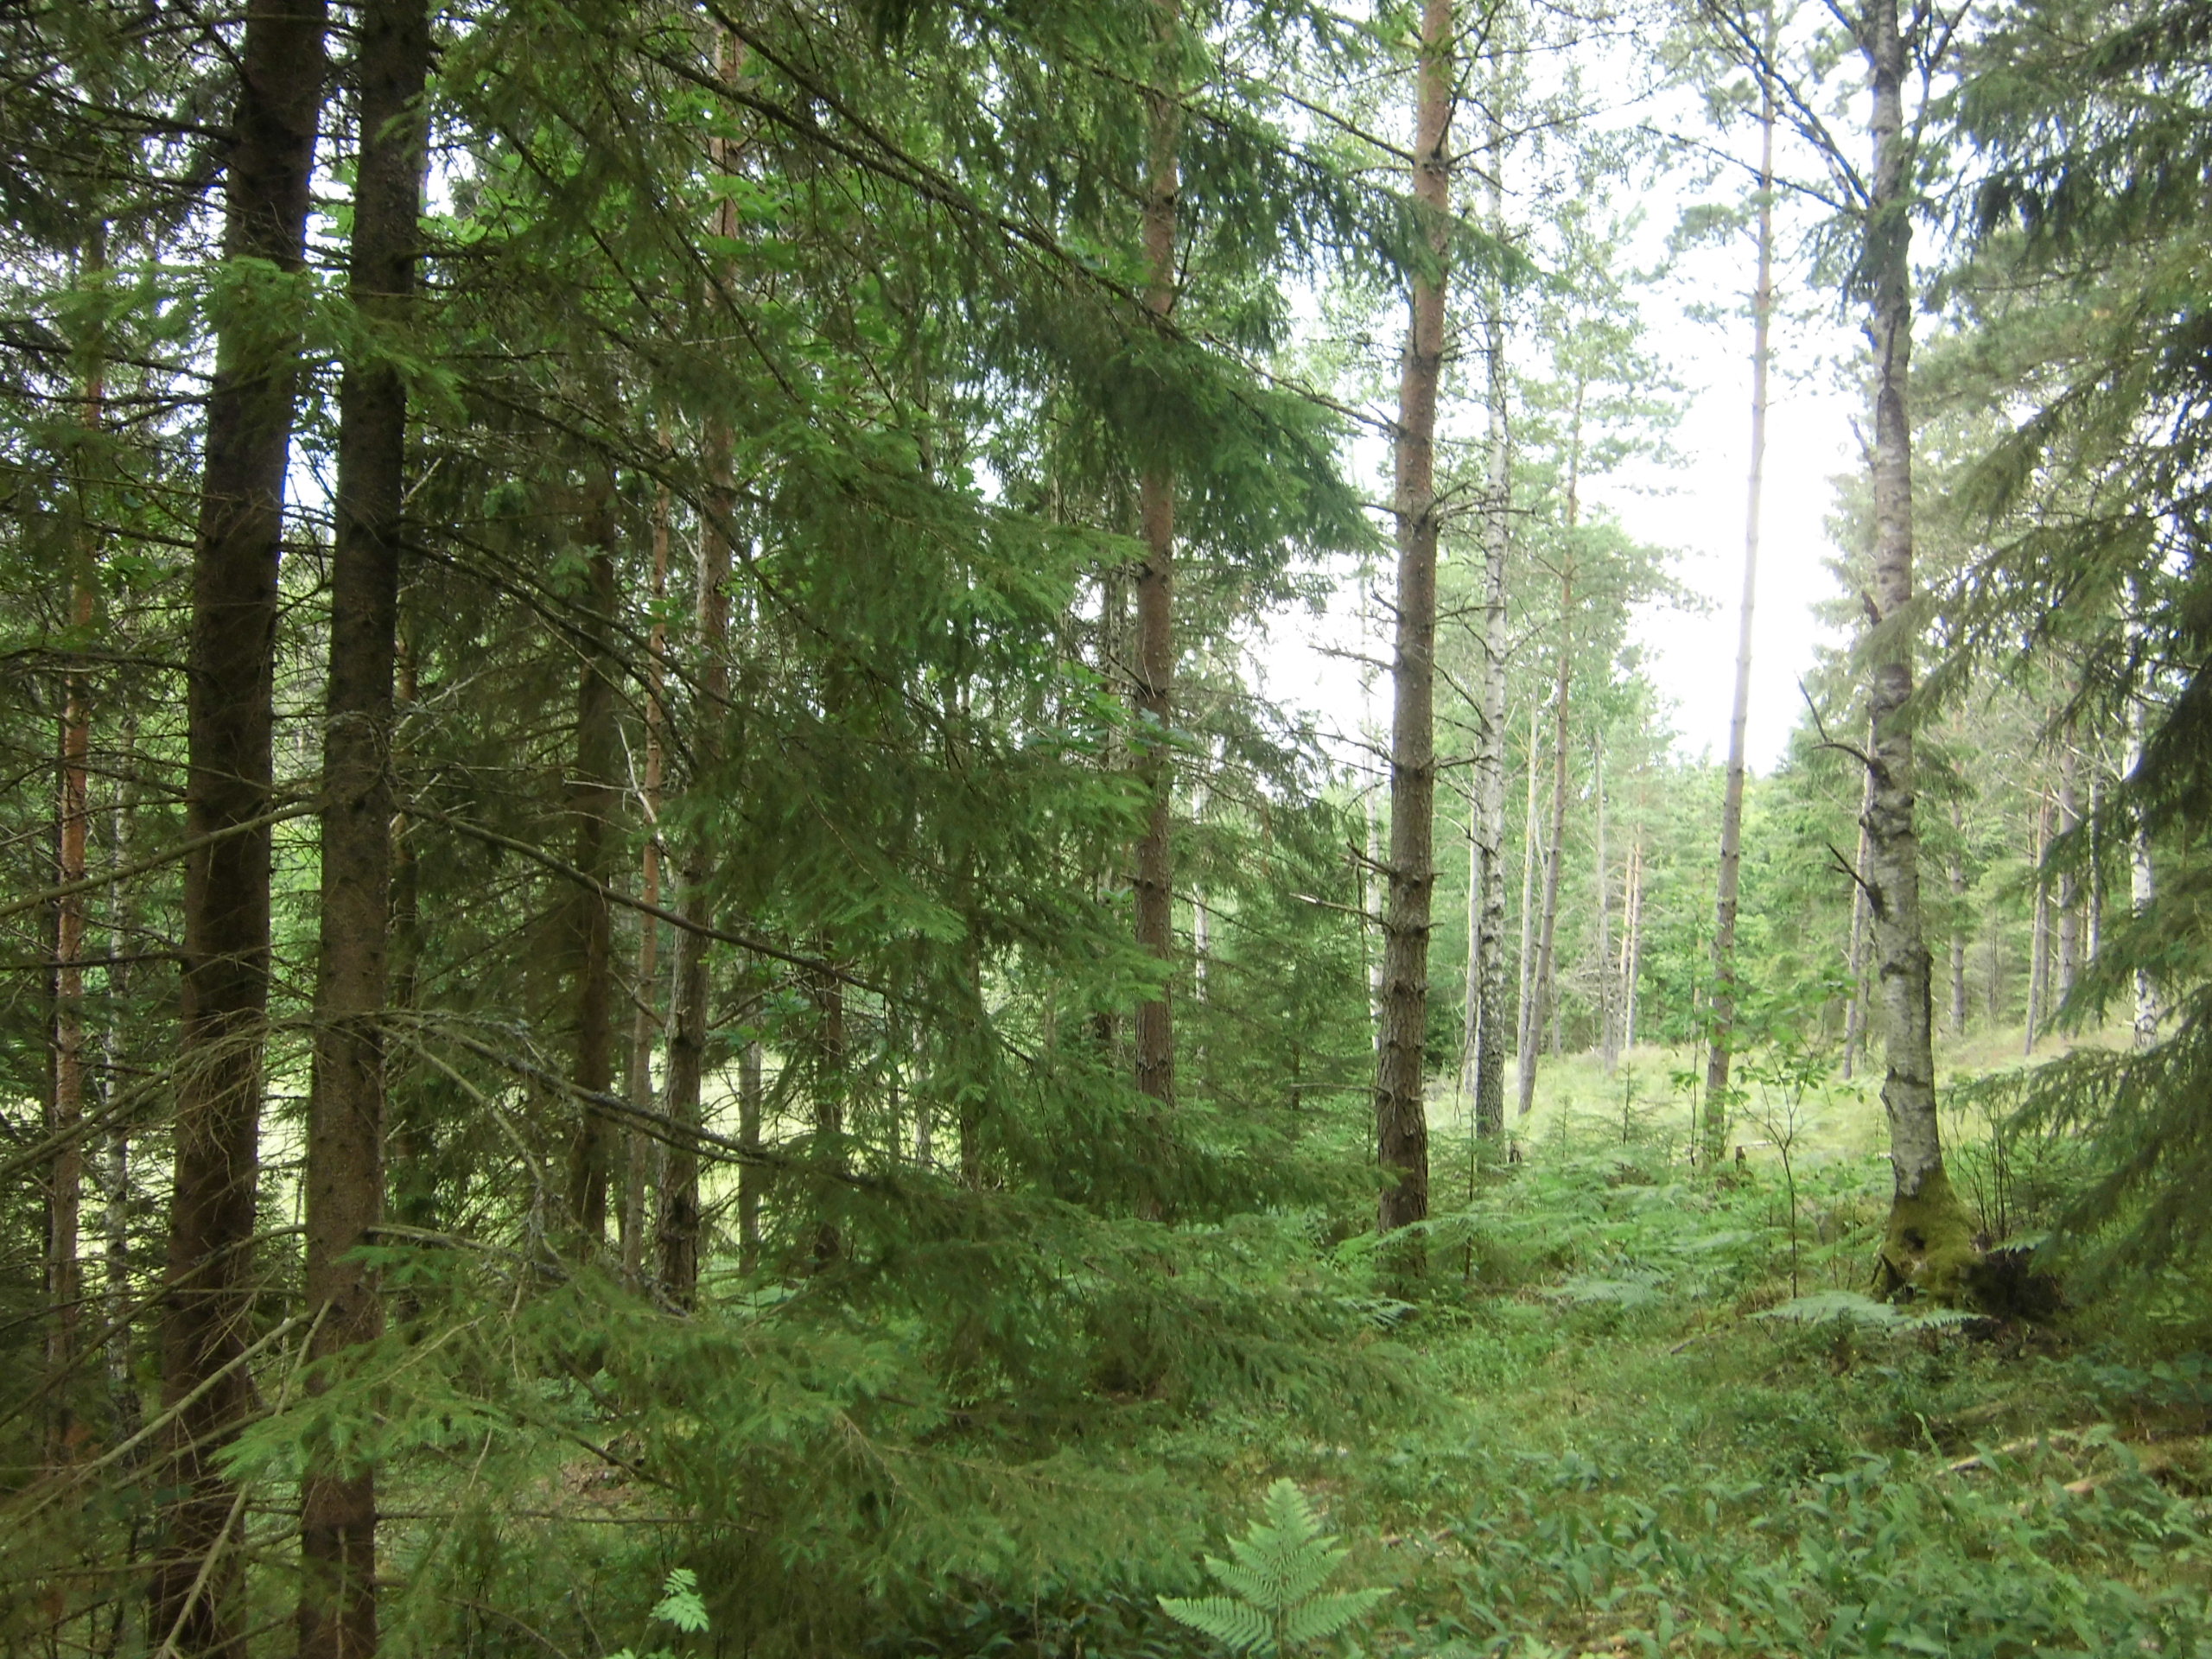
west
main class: Woodland
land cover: Pine dominated coniferous woodland
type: boreal forest
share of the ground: 50 - 75 %
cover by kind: coniferous forest trees 55 %, herbaceous plants 30 %, broadleaved forest trees 5 %, shrubs 5 %, lichens and mosses 5 %
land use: Forestry
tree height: > 5 m
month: July
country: SE
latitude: 57.3721
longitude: 14.9351
